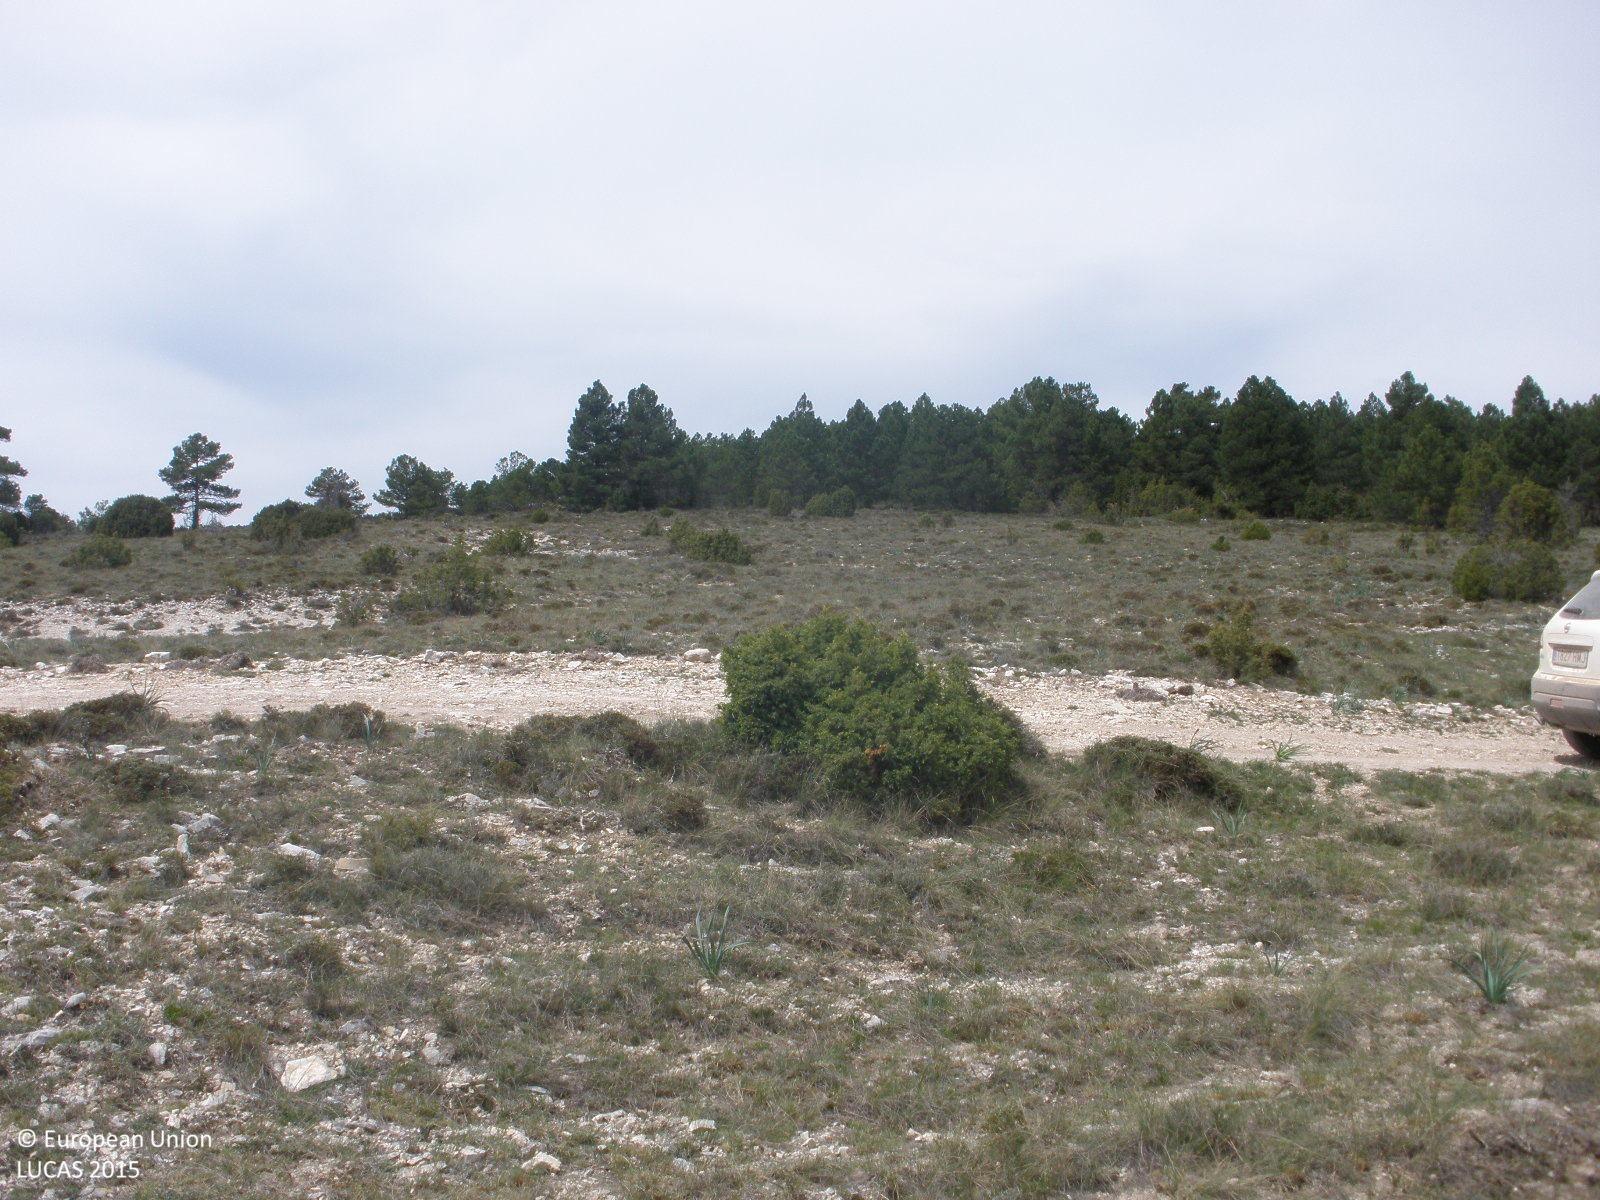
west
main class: Shrubland
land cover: Shrubland without tree cover
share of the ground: 25 - 50 %
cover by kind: herbaceous plants 40 %, shrubs 30 %, consolidated bare surface 30 %
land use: Semi-natural and natural areas not in use
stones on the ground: > 50 %
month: May
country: ES
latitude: 40.6197
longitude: -0.6134
